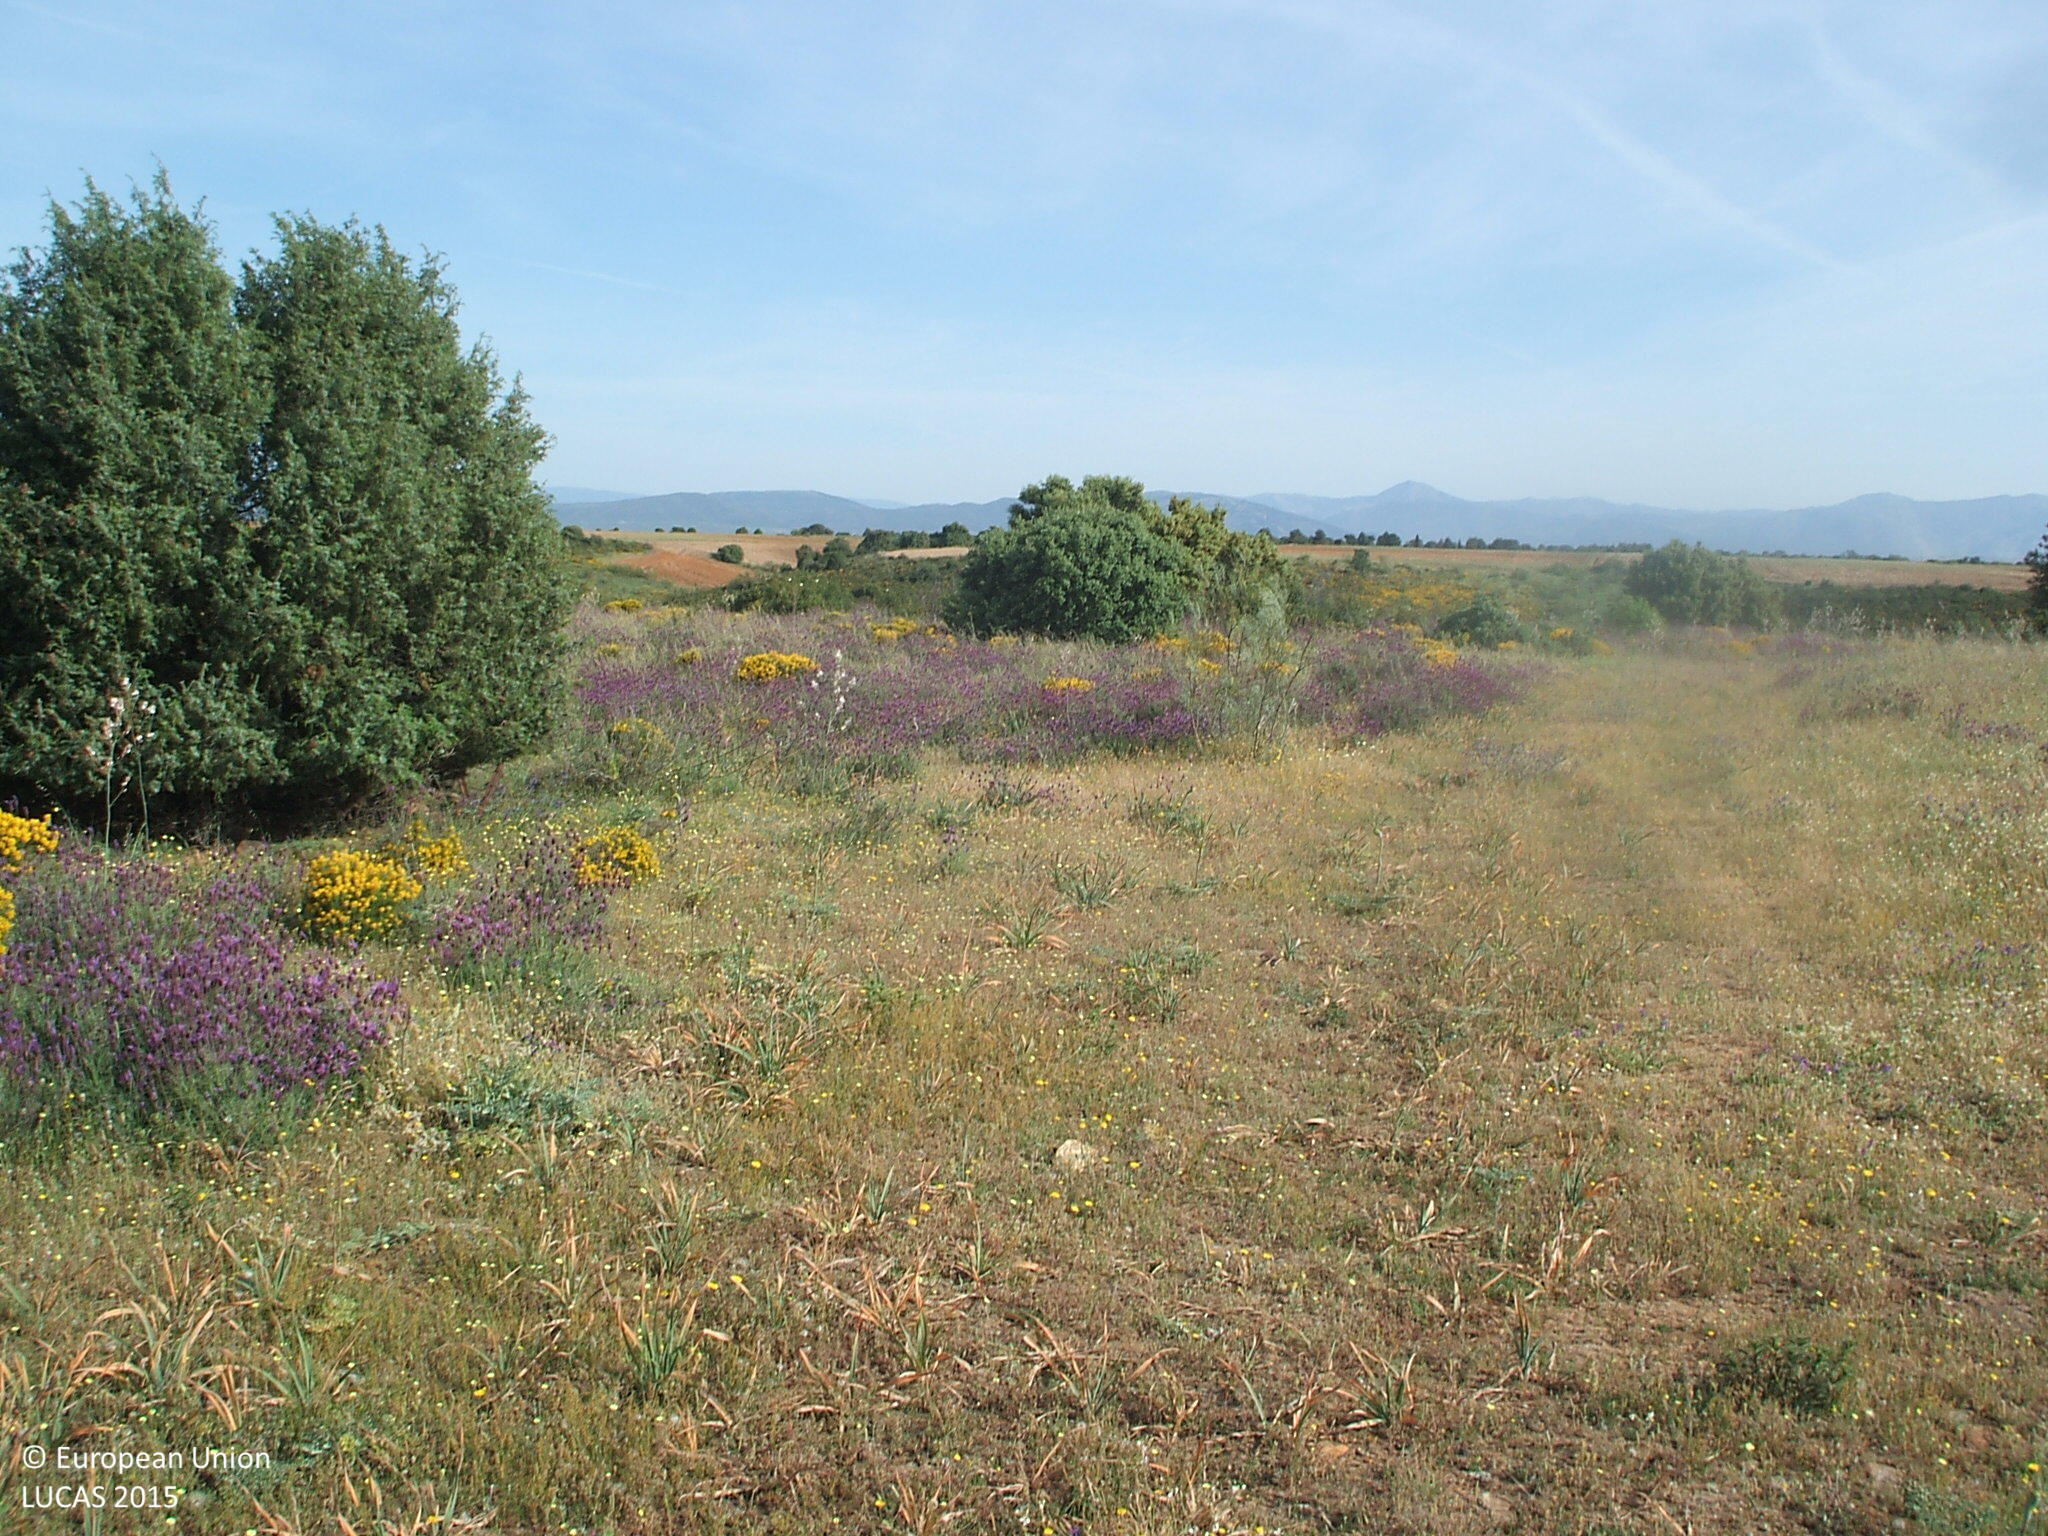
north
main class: Shrubland
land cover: Shrubland with sparse tree cover
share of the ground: 10 - 25 %
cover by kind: herbaceous plants 75 %, shrubs 20 %, broadleaved forest trees 5 %
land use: Semi-natural and natural areas not in use
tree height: > 5 m
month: May
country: ES
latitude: 40.7664
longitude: -3.4371
